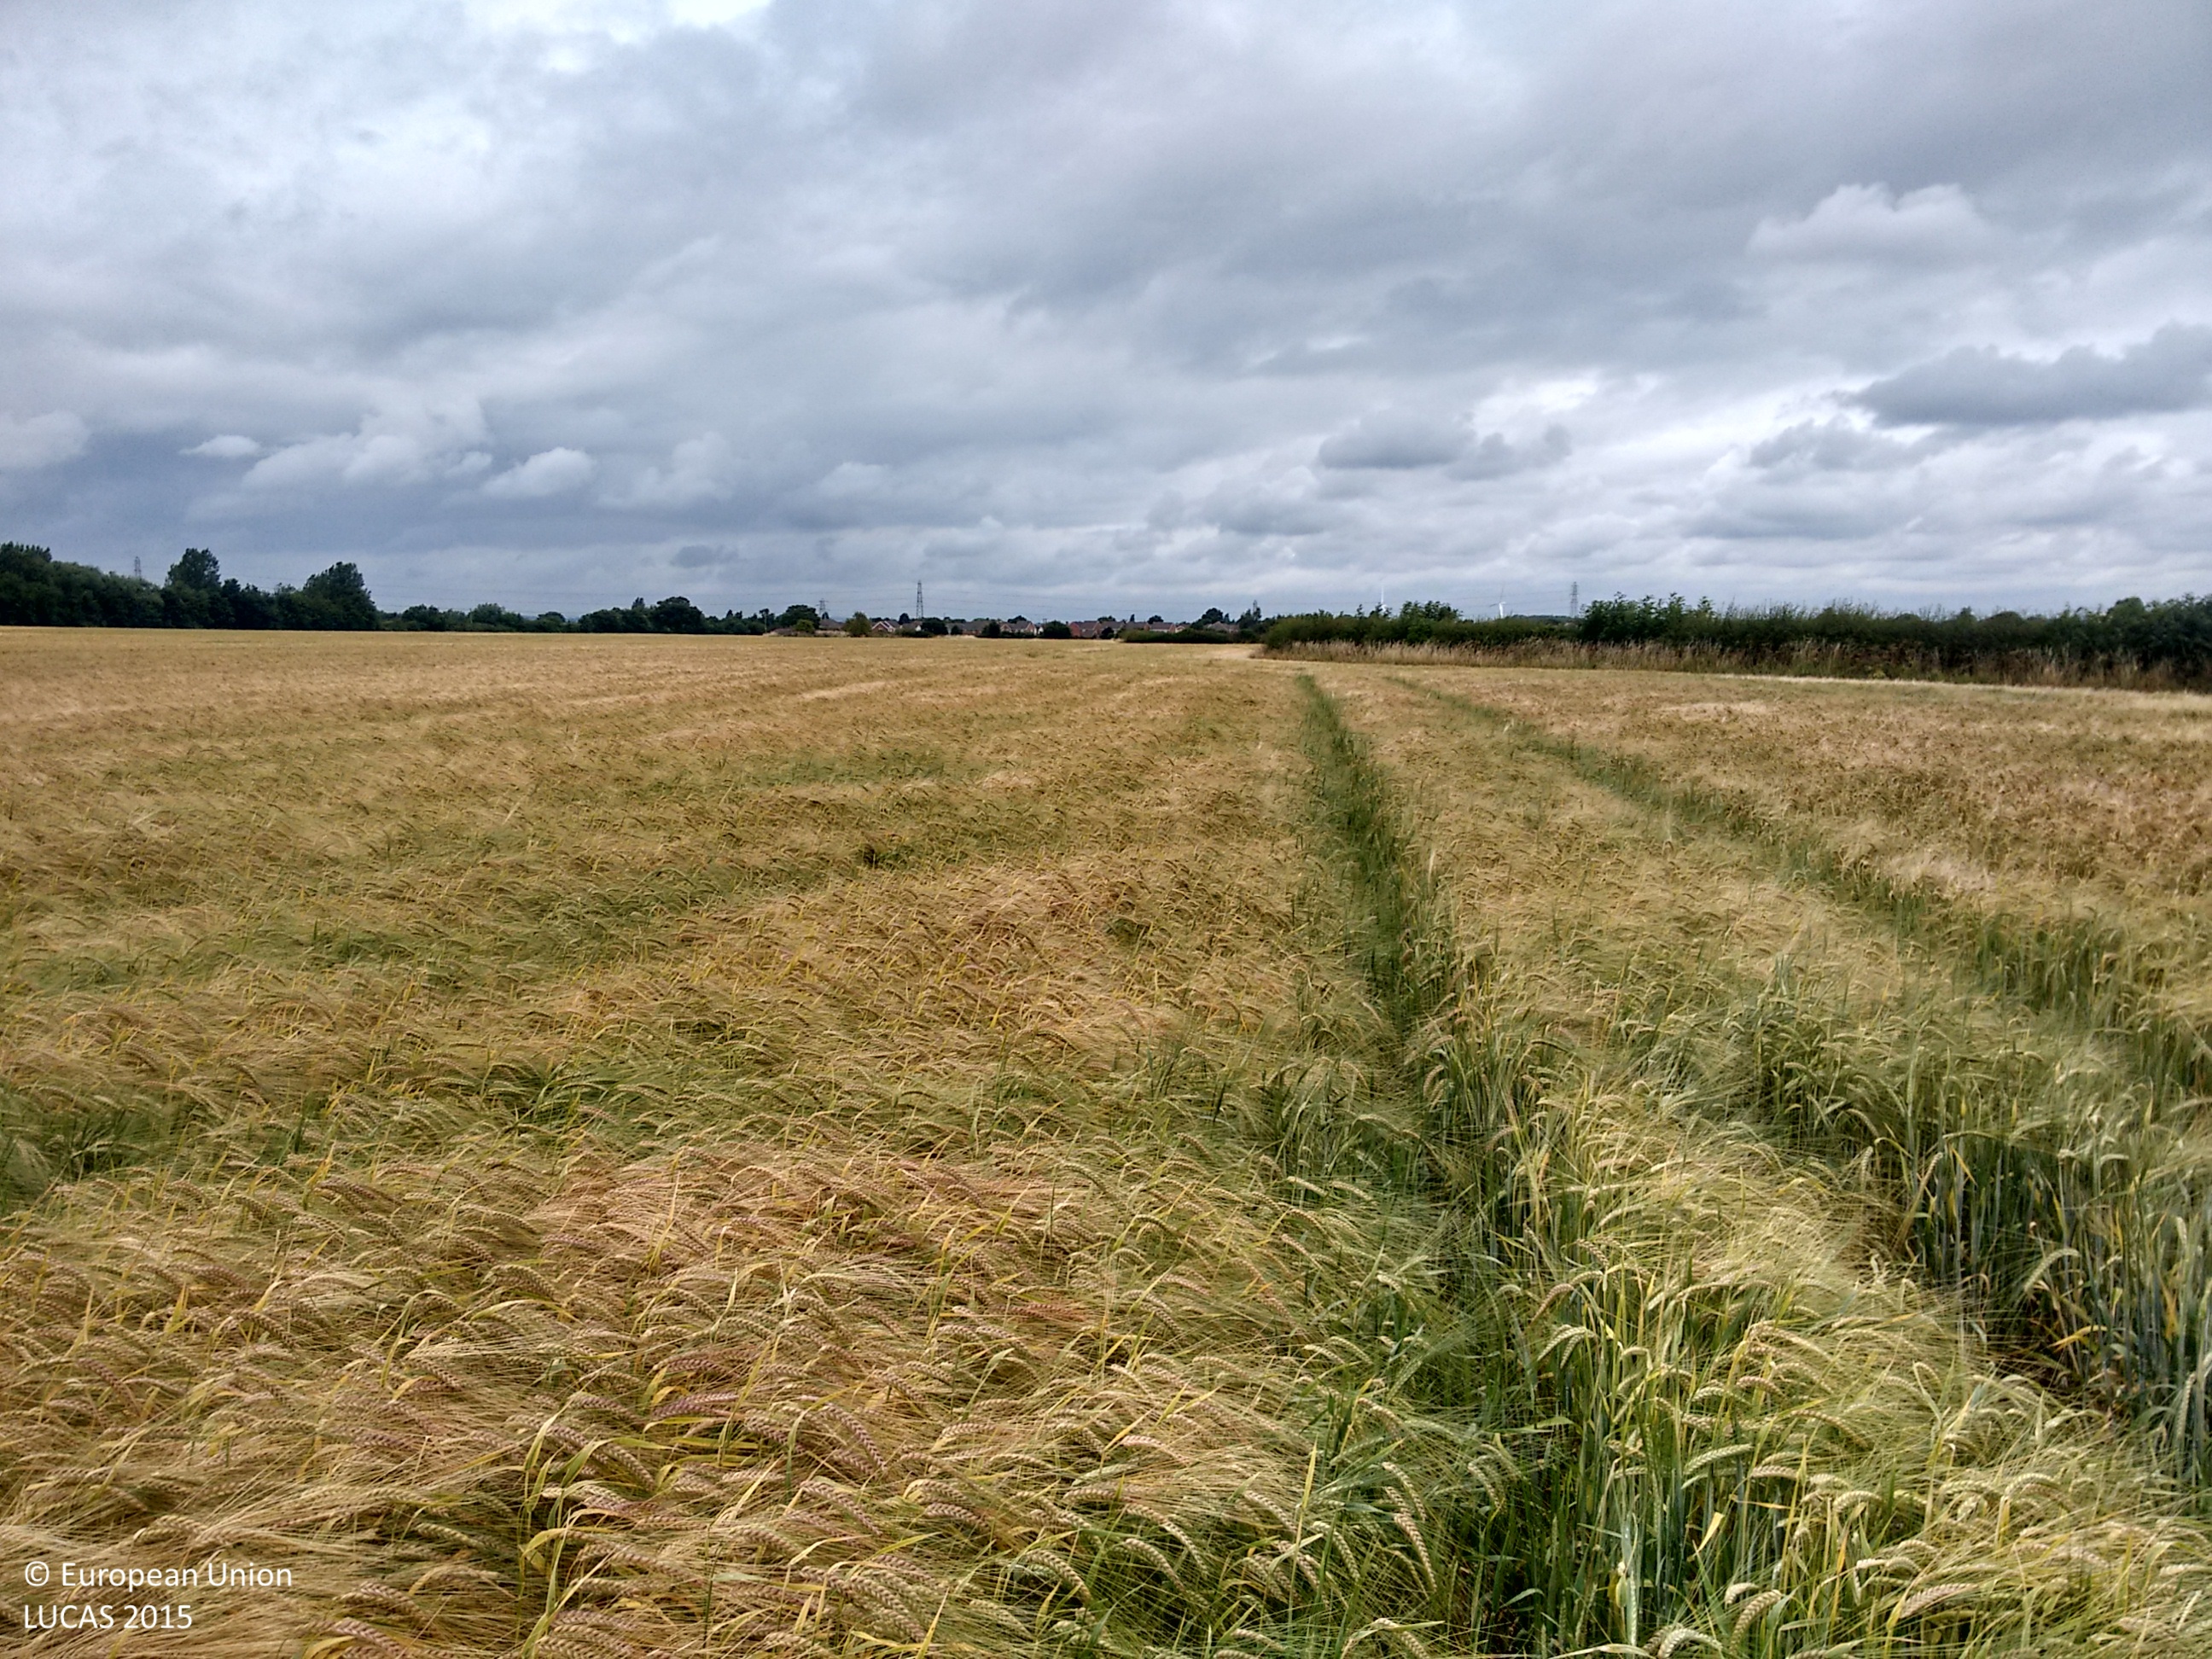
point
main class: Cropland
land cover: Barley
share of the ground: > 75 %
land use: Agriculture (excluding fallow land and kitchen gardens)
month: July
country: GB
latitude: 52.8781
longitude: -1.4165
